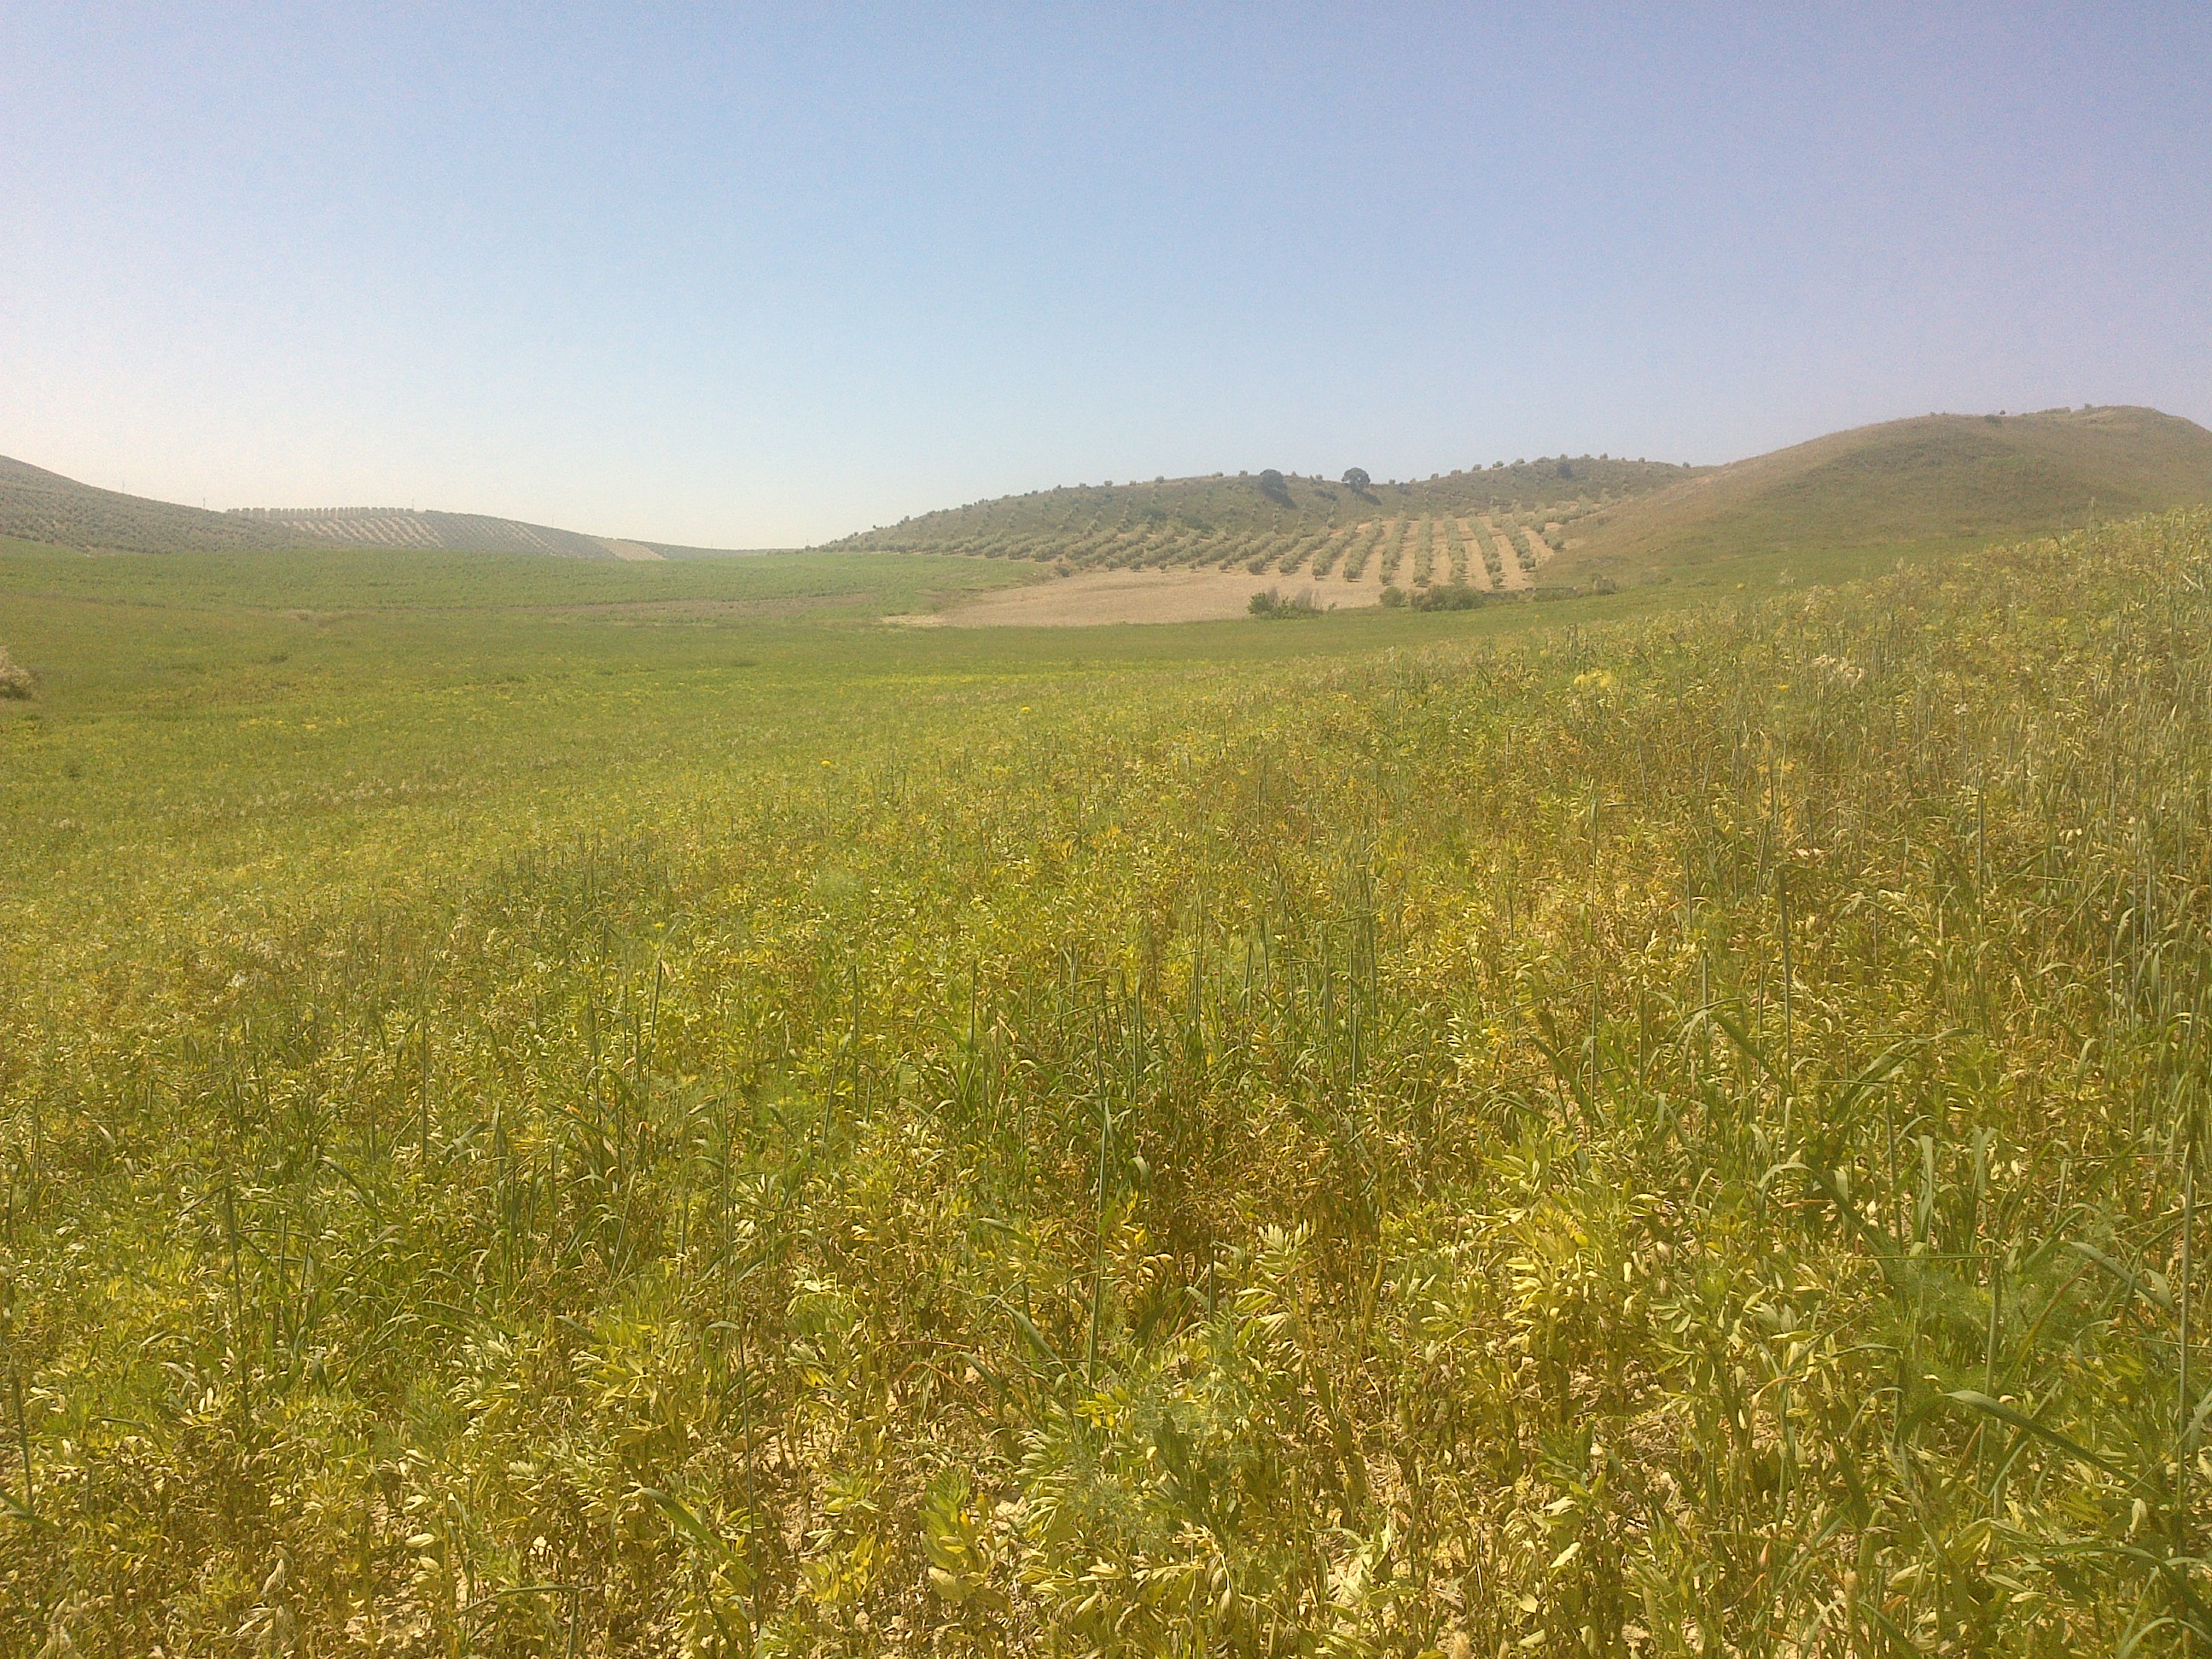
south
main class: Cropland
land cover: Dry pulses
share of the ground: > 75 %
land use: Agriculture (excluding fallow land and kitchen gardens)
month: May
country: ES
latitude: 37.7086
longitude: -4.5389
